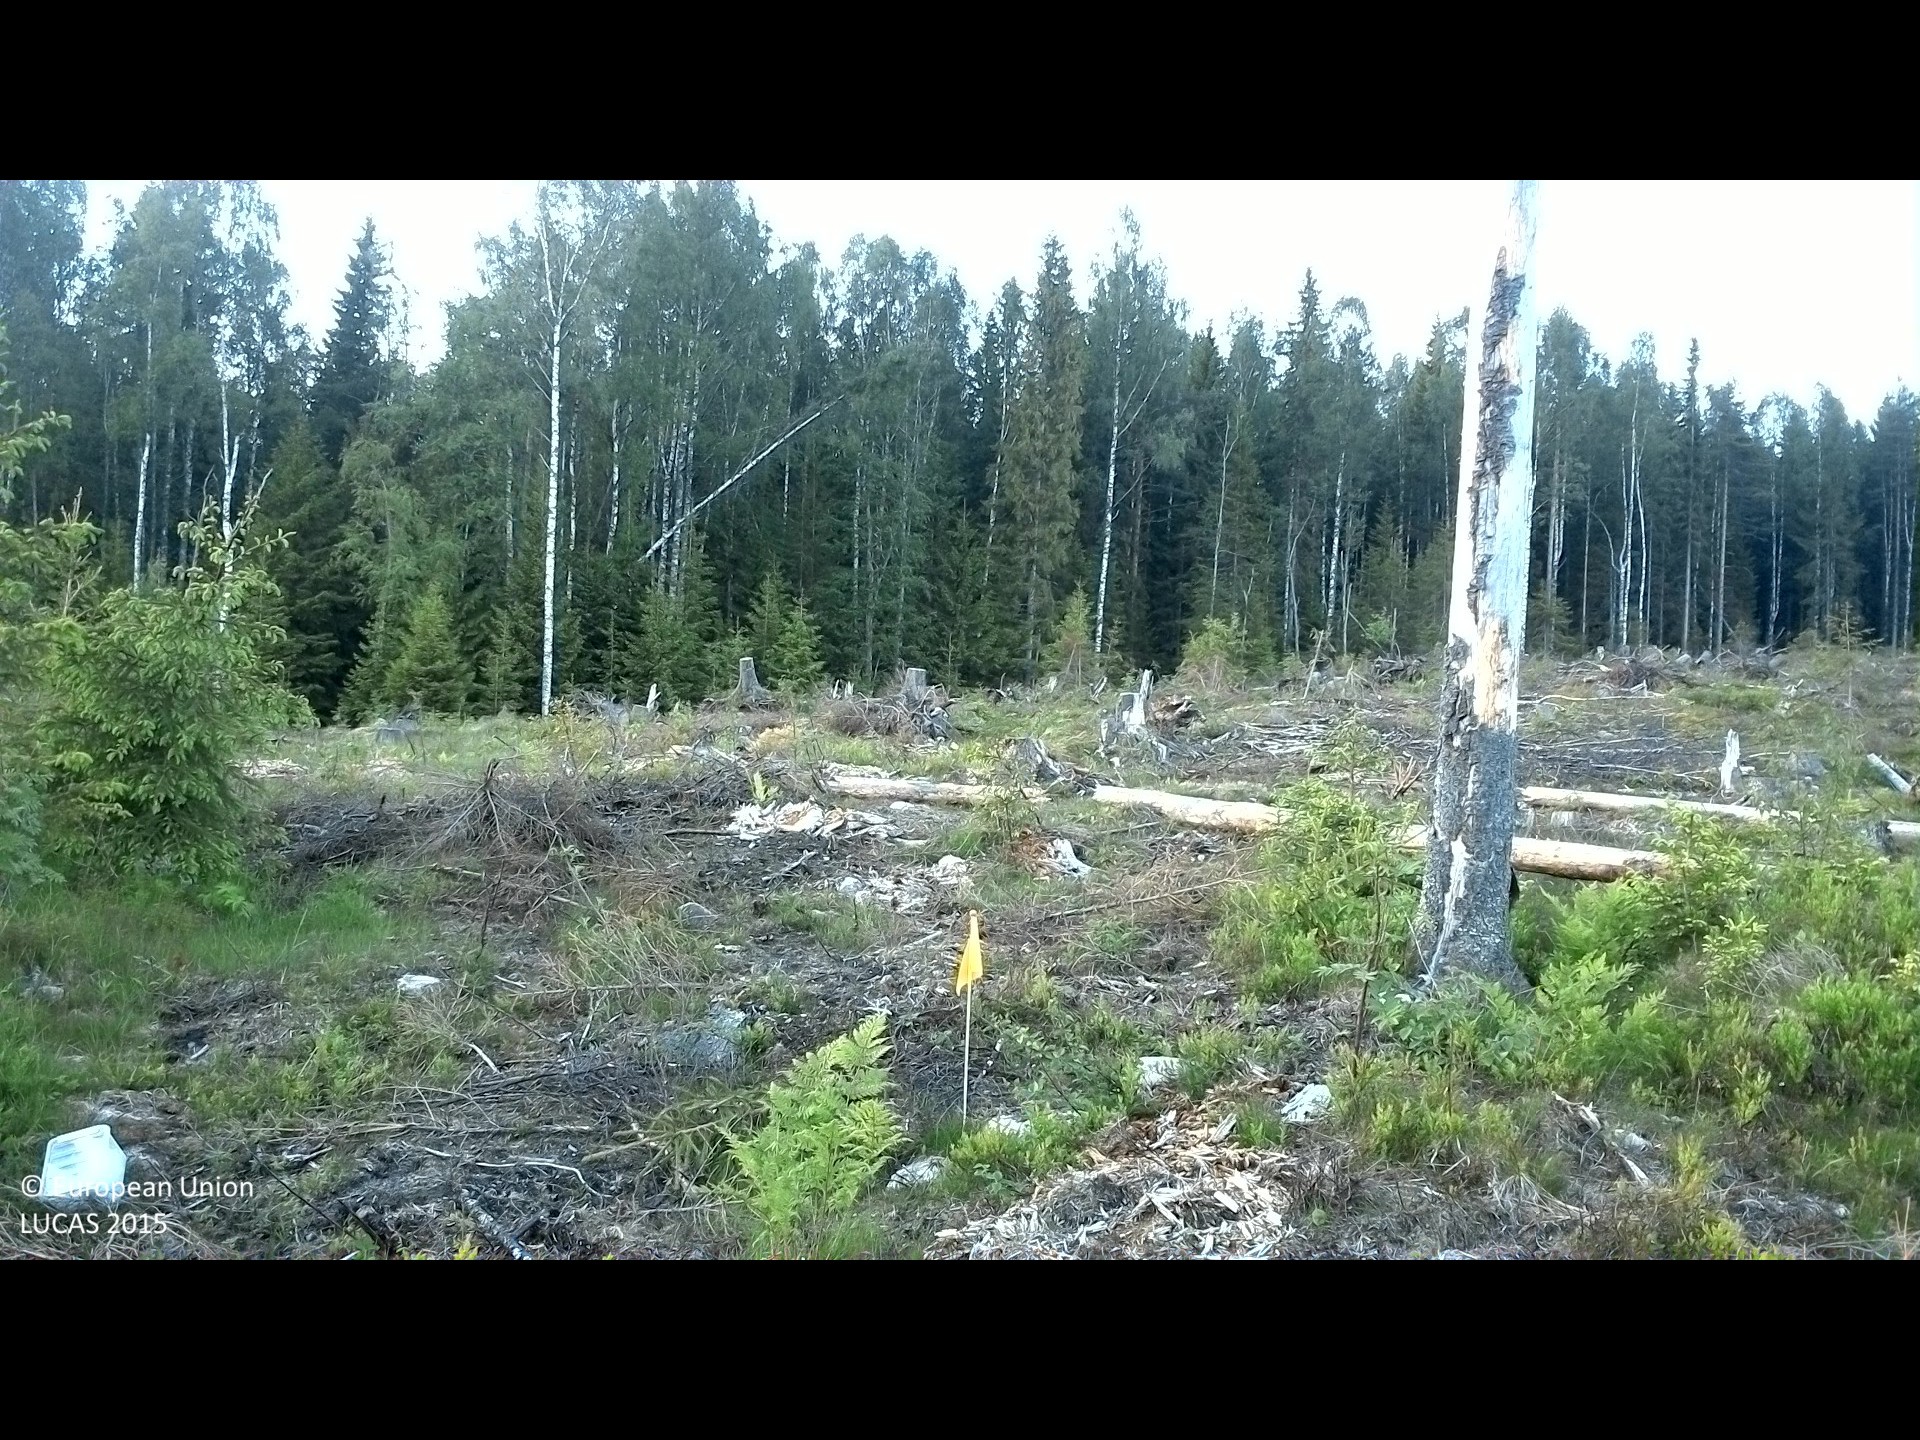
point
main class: Shrubland
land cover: Shrubland with sparse tree cover
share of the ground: 25 - 50 %
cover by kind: unconsolidated bare surface 50 %, shrubs 30 %, herbaceous plants 15 %, coniferous forest trees 5 %
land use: Forestry
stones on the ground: 10 - 25 %
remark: Clear cut
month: June
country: SE
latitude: 62.0114
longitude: 16.6862
